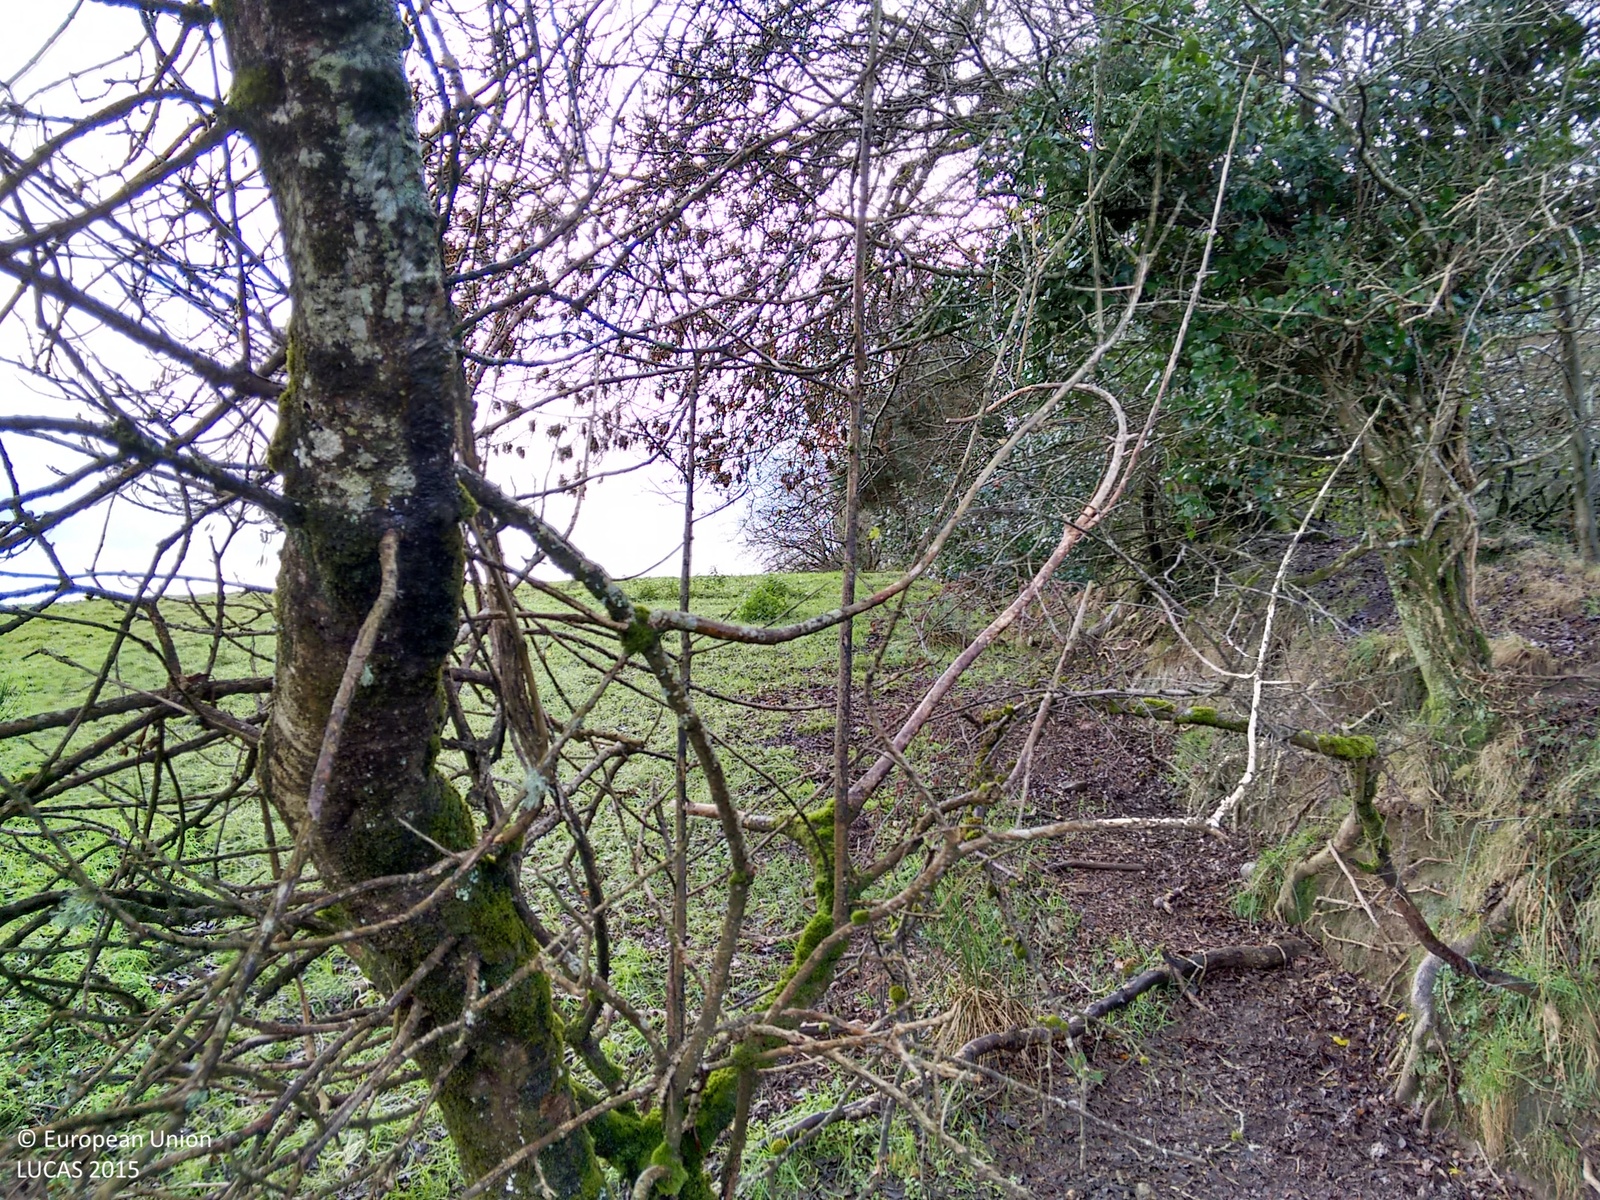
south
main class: Shrubland
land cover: Shrubland without tree cover
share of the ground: > 75 %
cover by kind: herbaceous plants 80 %, shrubs 20 %
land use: Agriculture (excluding fallow land and kitchen gardens)
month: November
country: IE
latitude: 54.6553
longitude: -8.1424
